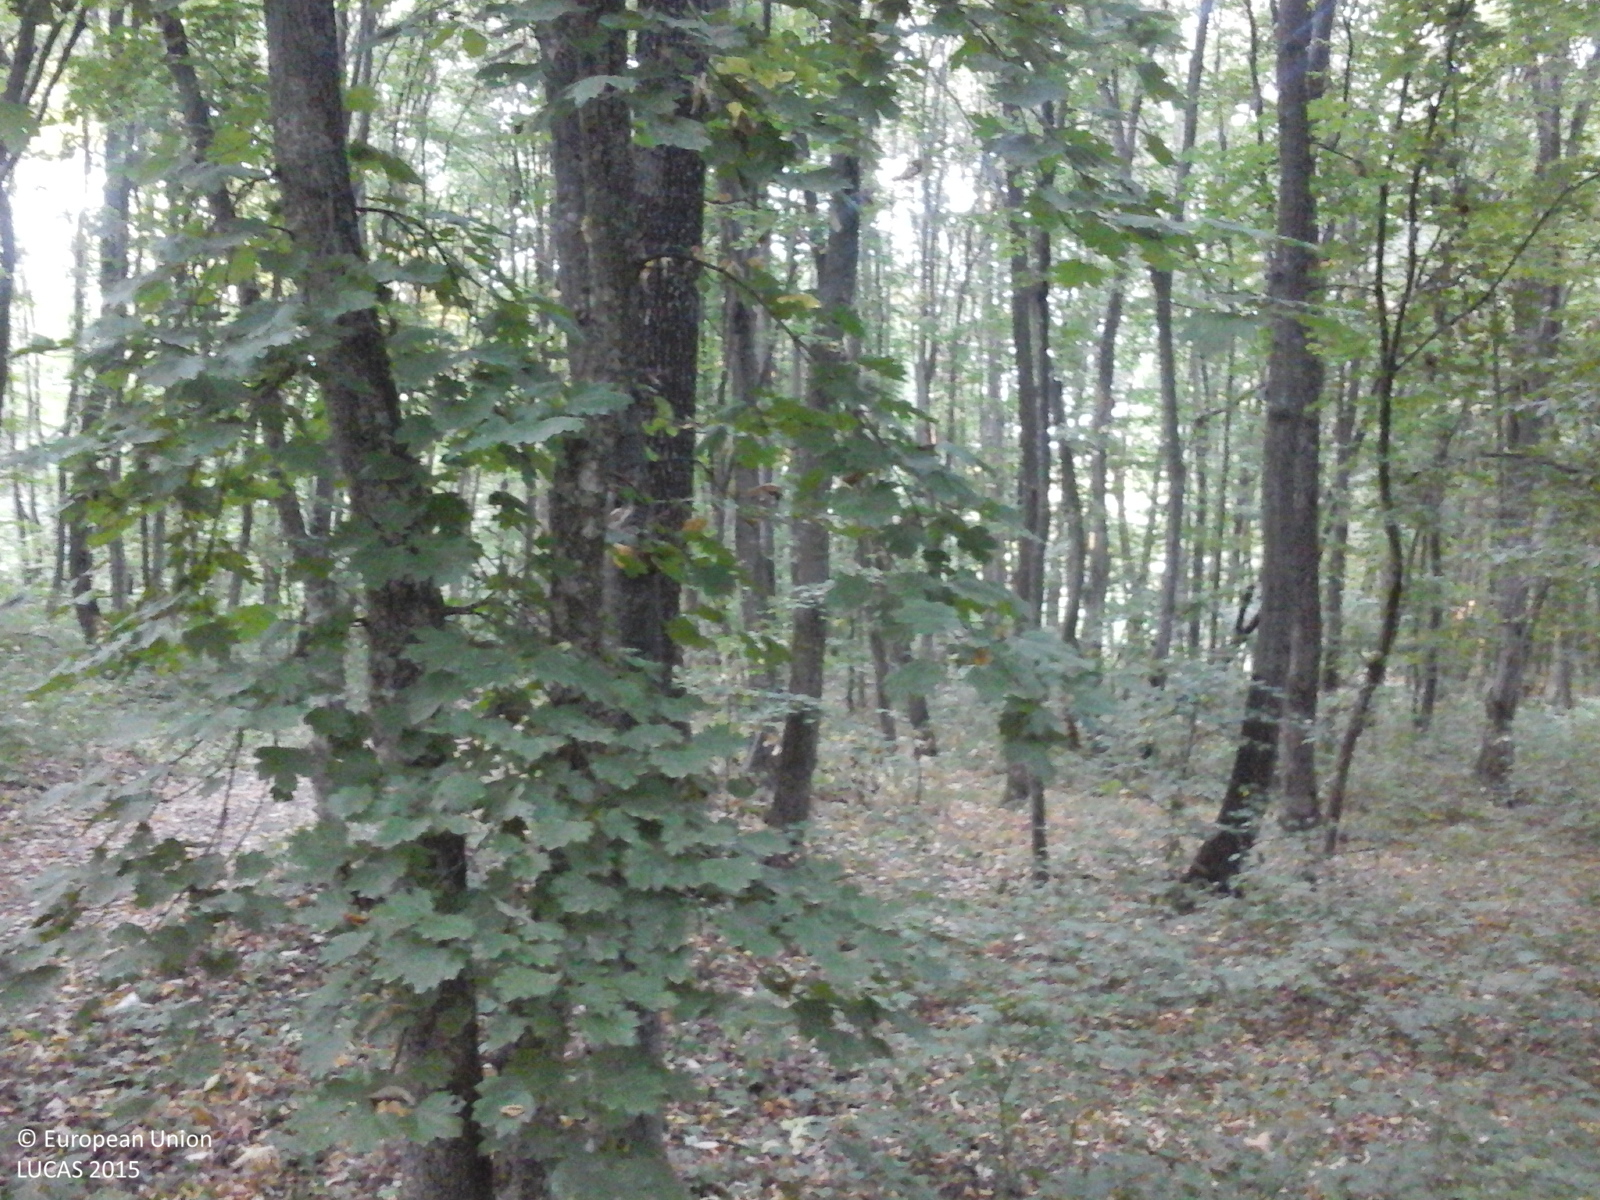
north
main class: Woodland
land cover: Broadleaved woodland
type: mesophytic deciduous forest
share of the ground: > 75 %
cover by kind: broadleaved forest trees 100 %
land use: Forestry
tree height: > 5 m
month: July
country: RO
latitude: 45.1818
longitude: 28.3892
